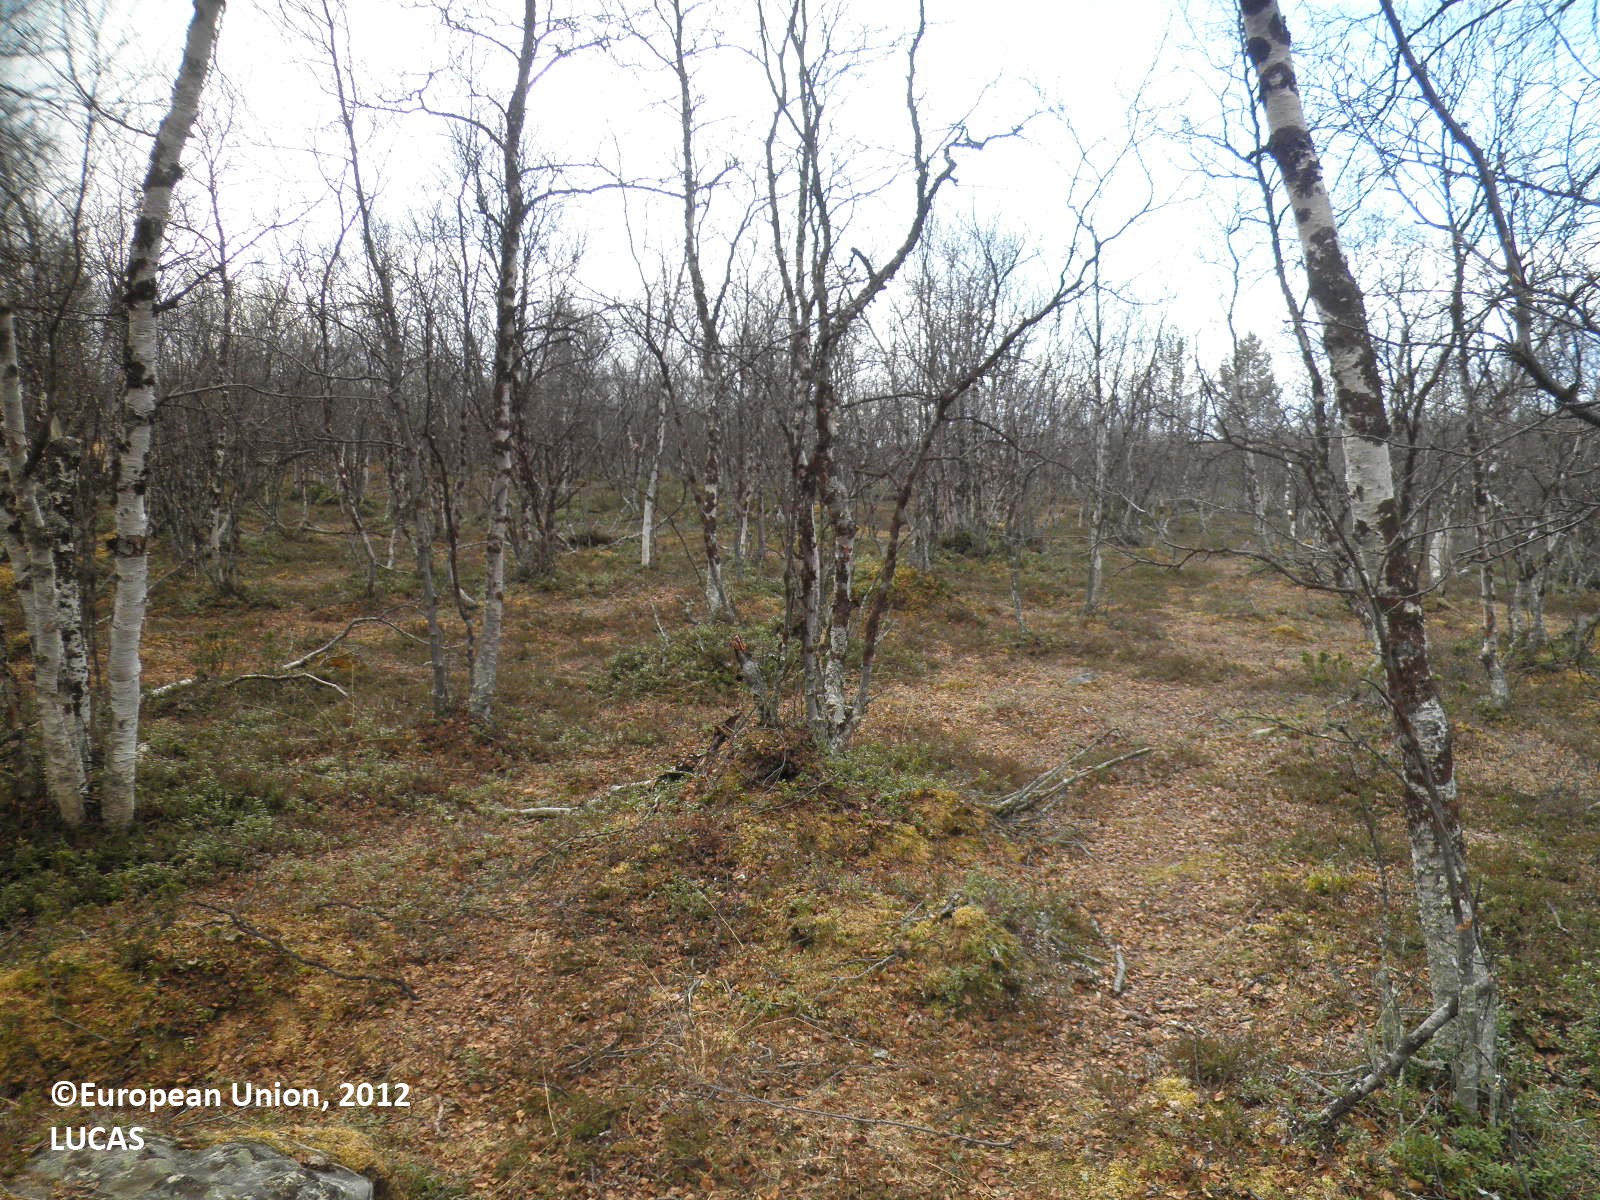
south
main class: Woodland
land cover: Broadleaved woodland
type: boreal forest
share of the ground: 50 - 75 %
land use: Forestry
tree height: > 5 m
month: May
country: FI
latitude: 69.3782
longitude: 27.2293
